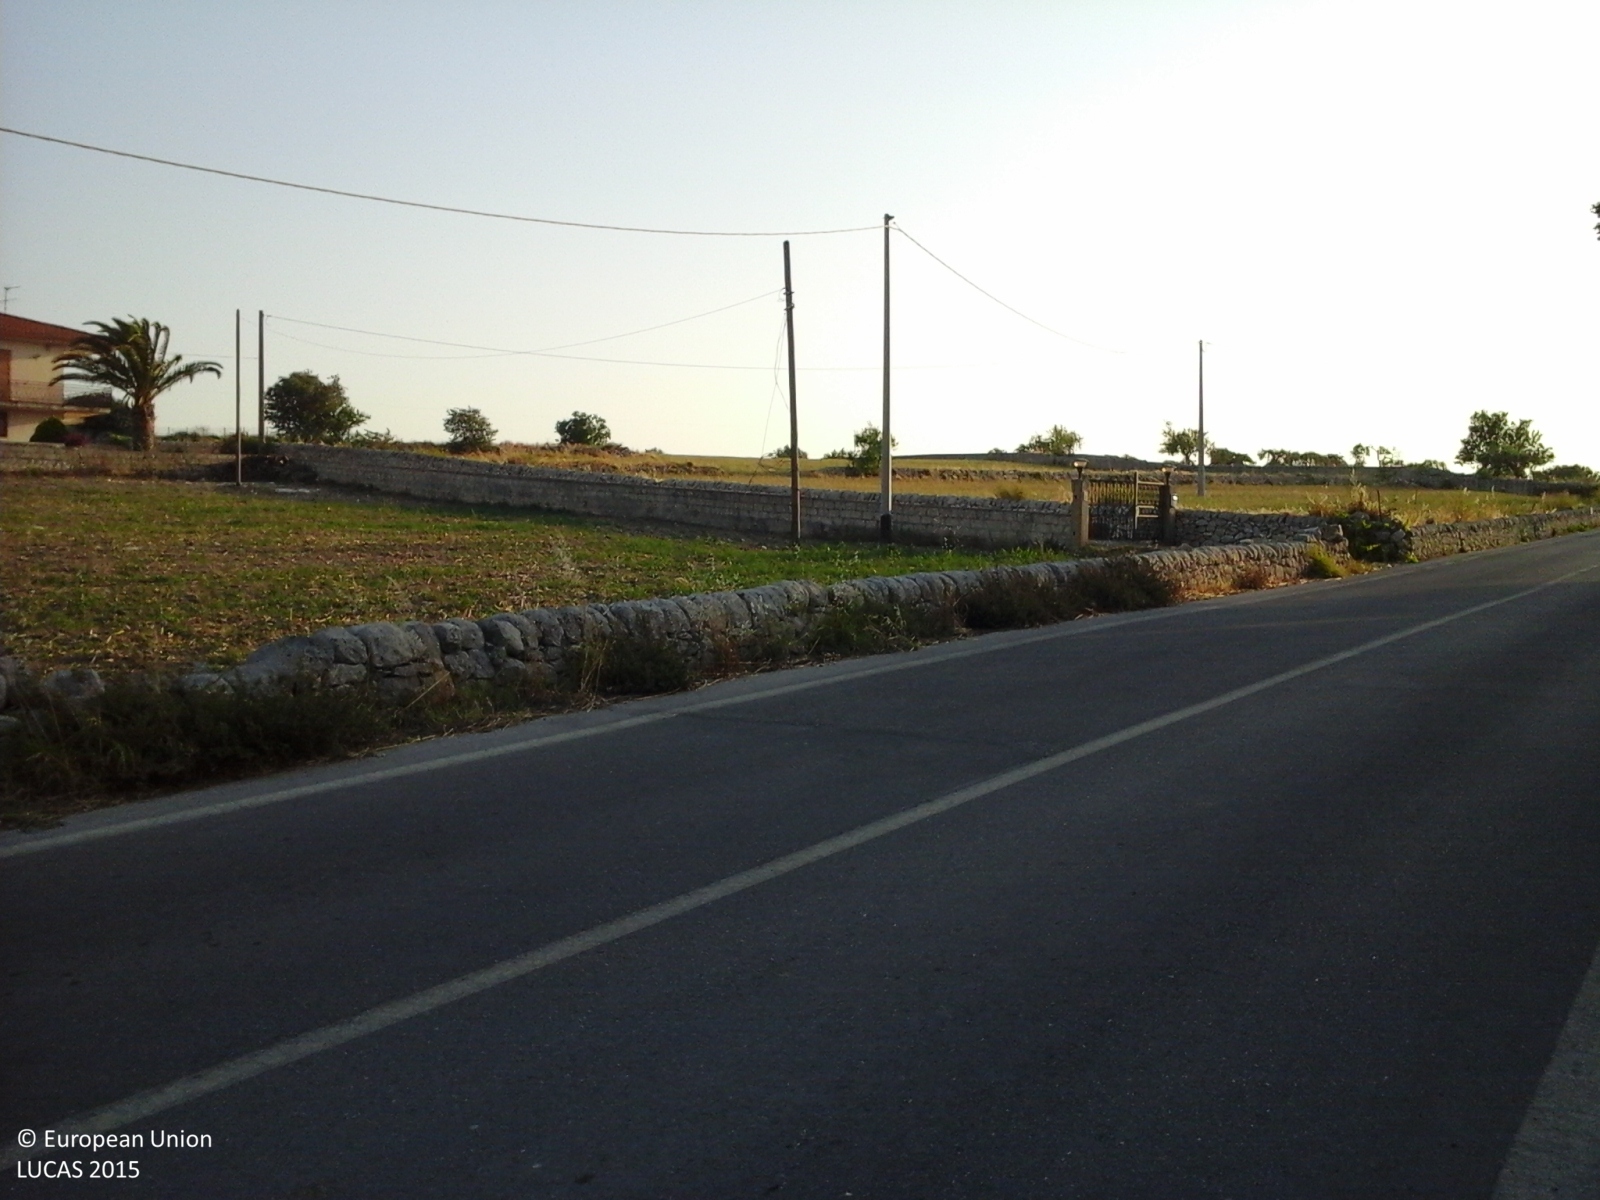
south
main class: Grassland
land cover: Grassland without tree/shrub cover
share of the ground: > 75 %
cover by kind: herbaceous plants 100 %
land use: Agriculture (excluding fallow land and kitchen gardens)
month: July
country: IT
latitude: 36.8954
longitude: 14.8653
